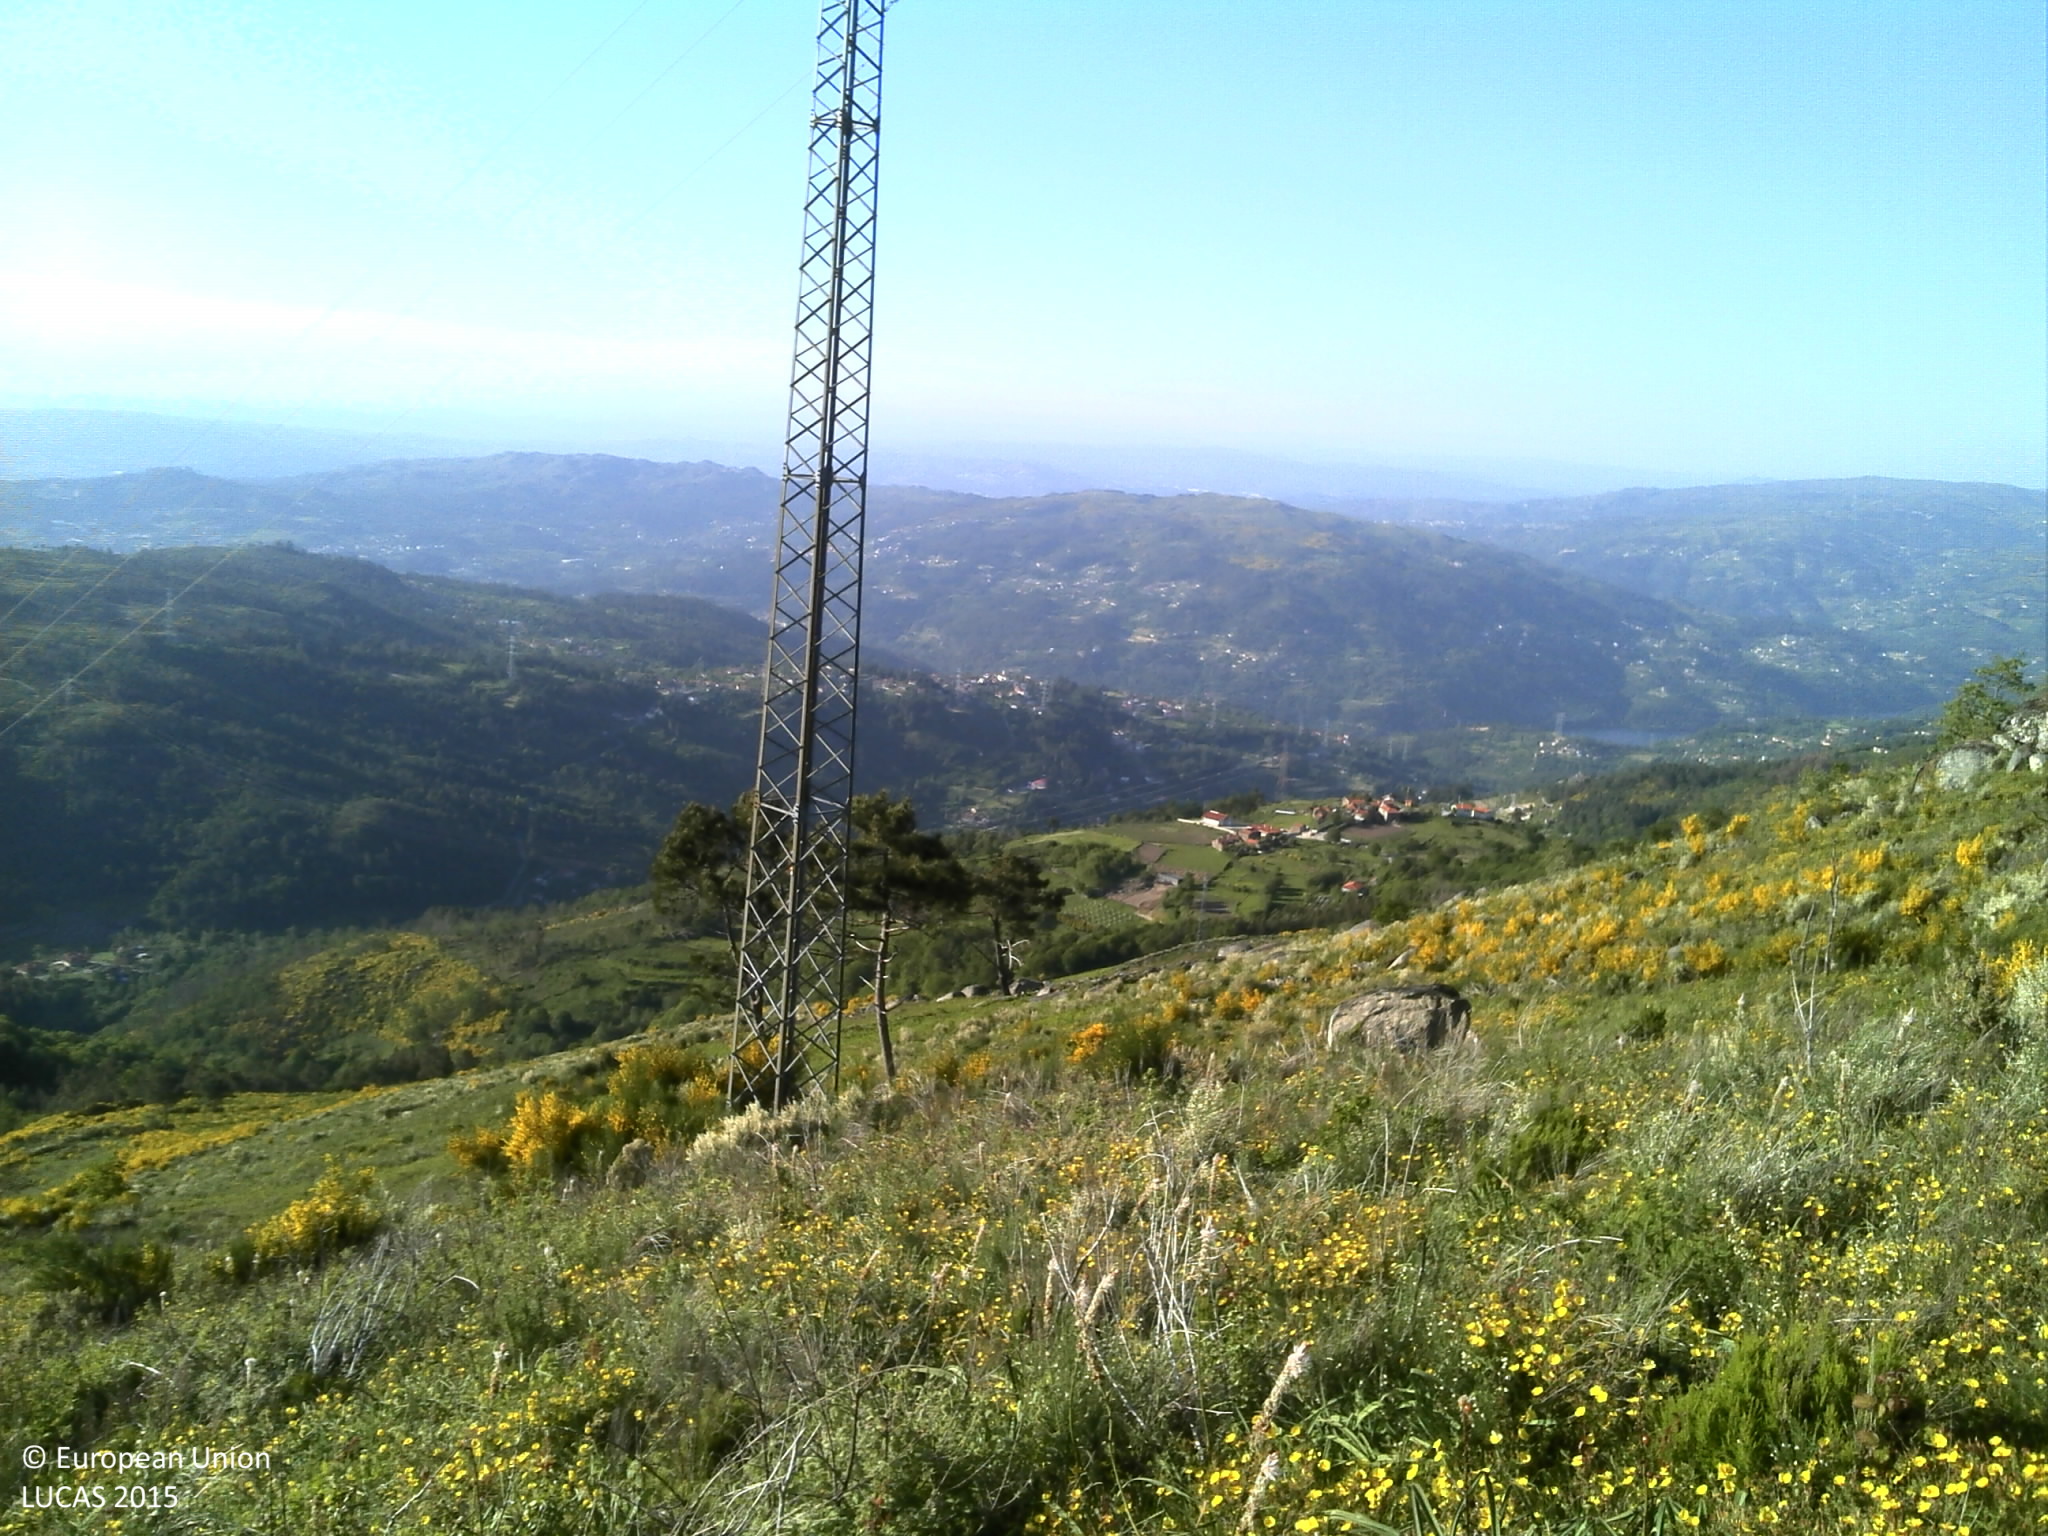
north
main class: Shrubland
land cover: Shrubland without tree cover
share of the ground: > 75 %
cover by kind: shrubs 80 %, unconsolidated bare surface 15 %, herbaceous plants 5 %
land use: Agriculture (excluding fallow land and kitchen gardens)
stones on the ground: < 10 %
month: May
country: PT
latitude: 41.0334
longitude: -8.1576
